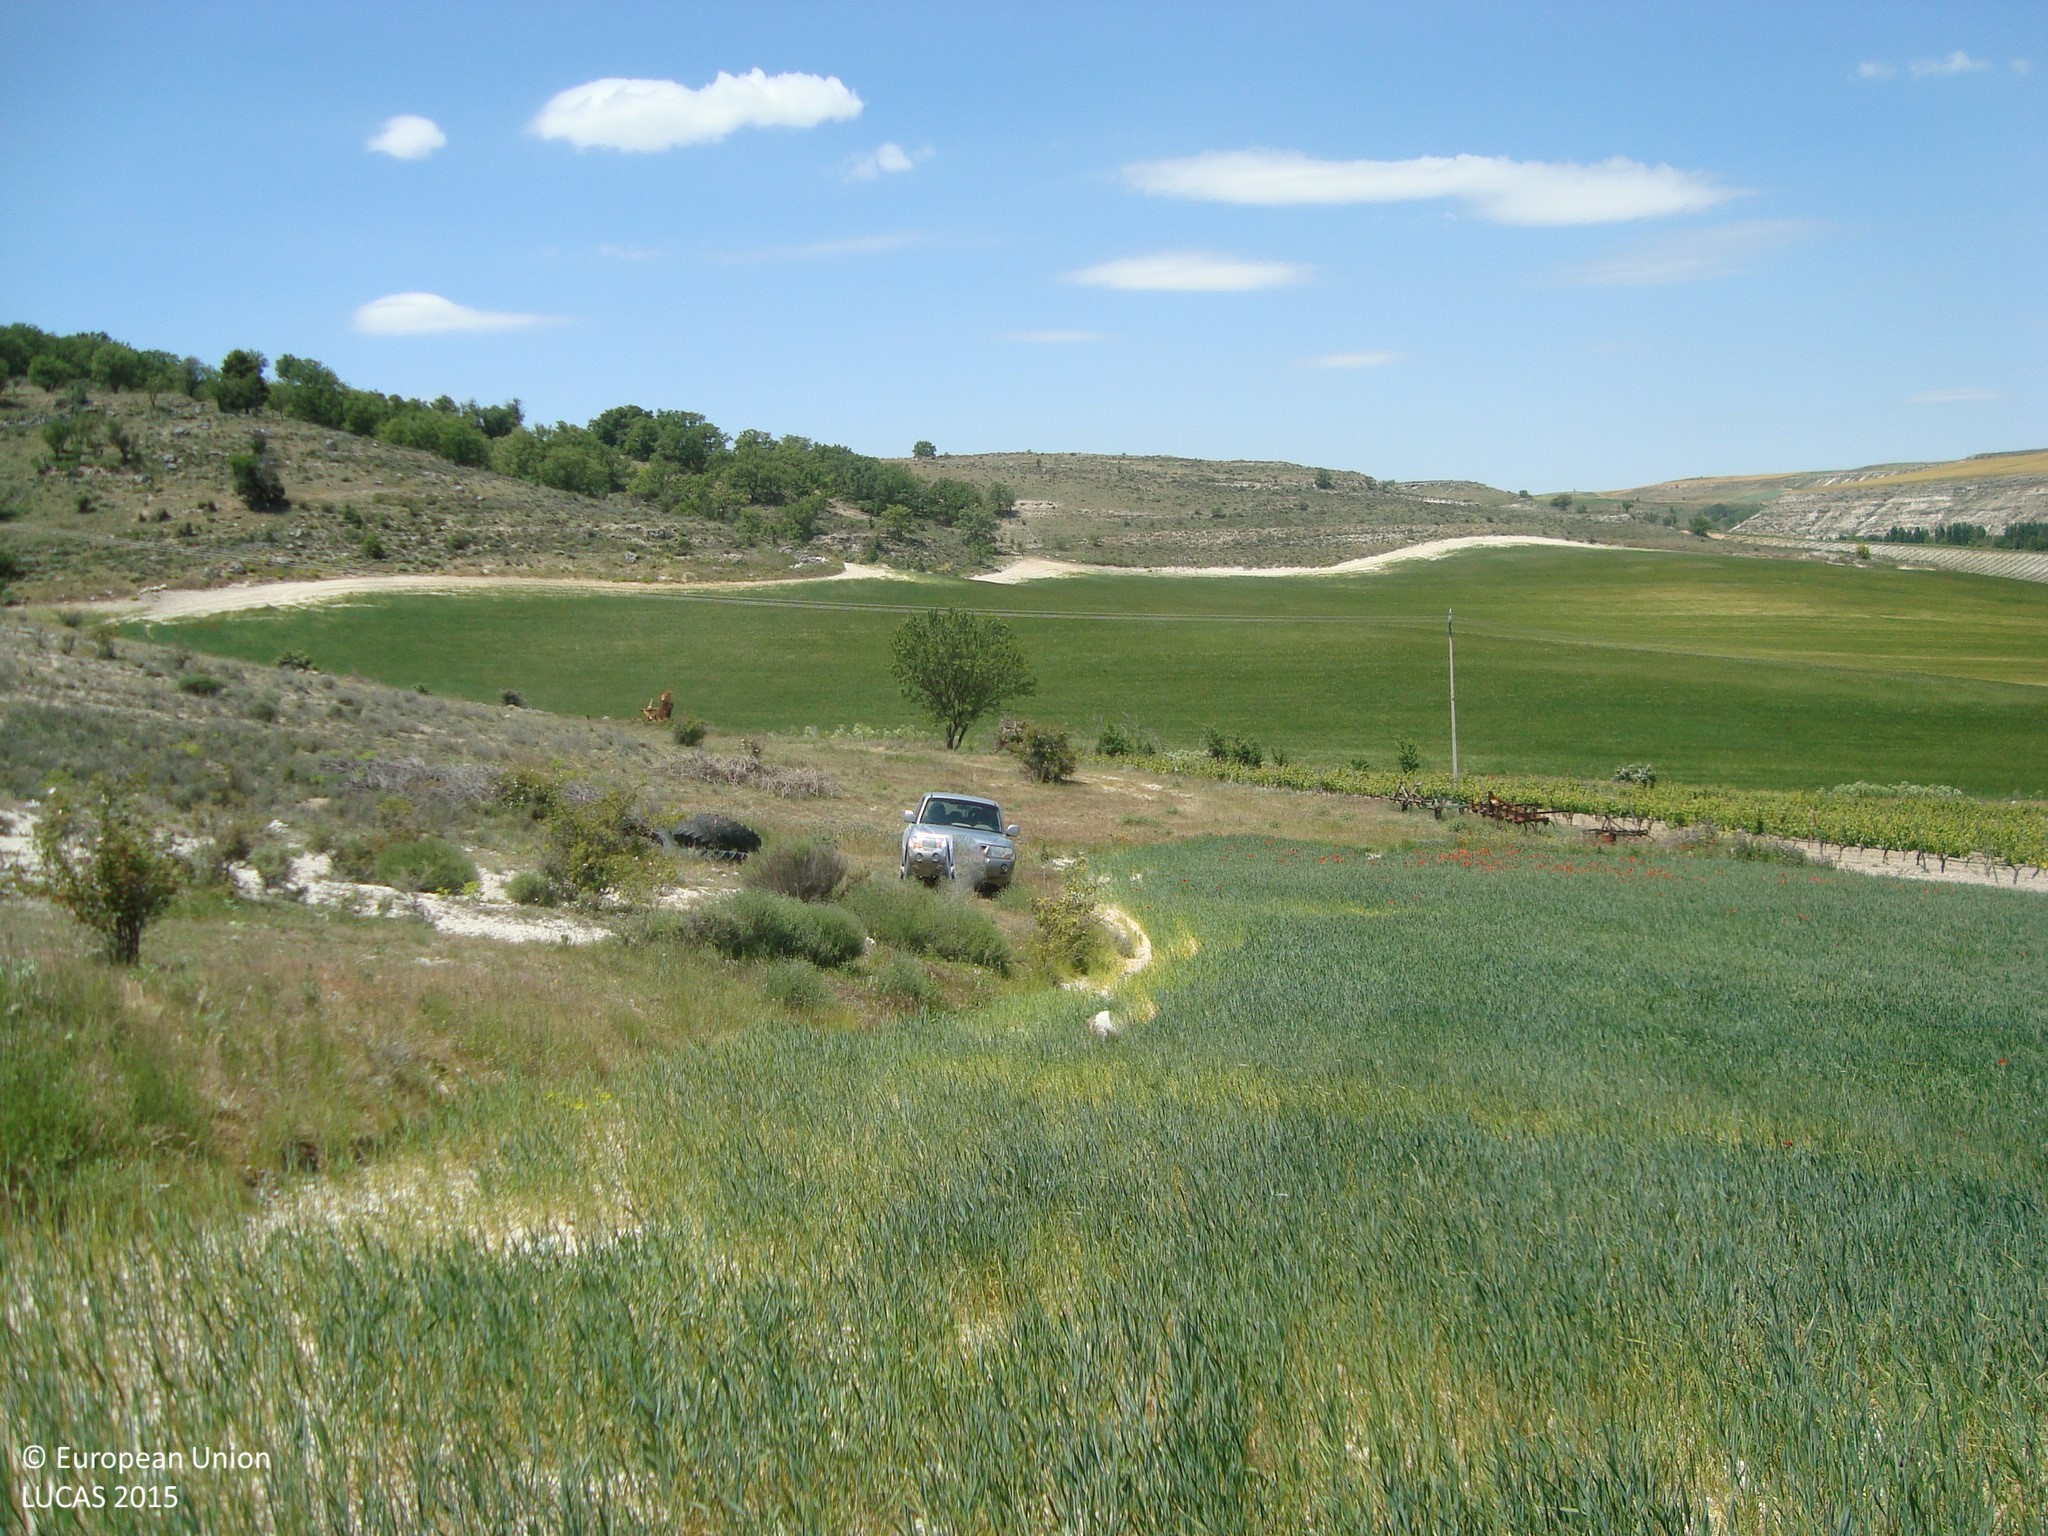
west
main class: Cropland
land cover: Common wheat
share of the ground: 50 - 75 %
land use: Agriculture (excluding fallow land and kitchen gardens)
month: May
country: ES
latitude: 41.5459
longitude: -4.1440
